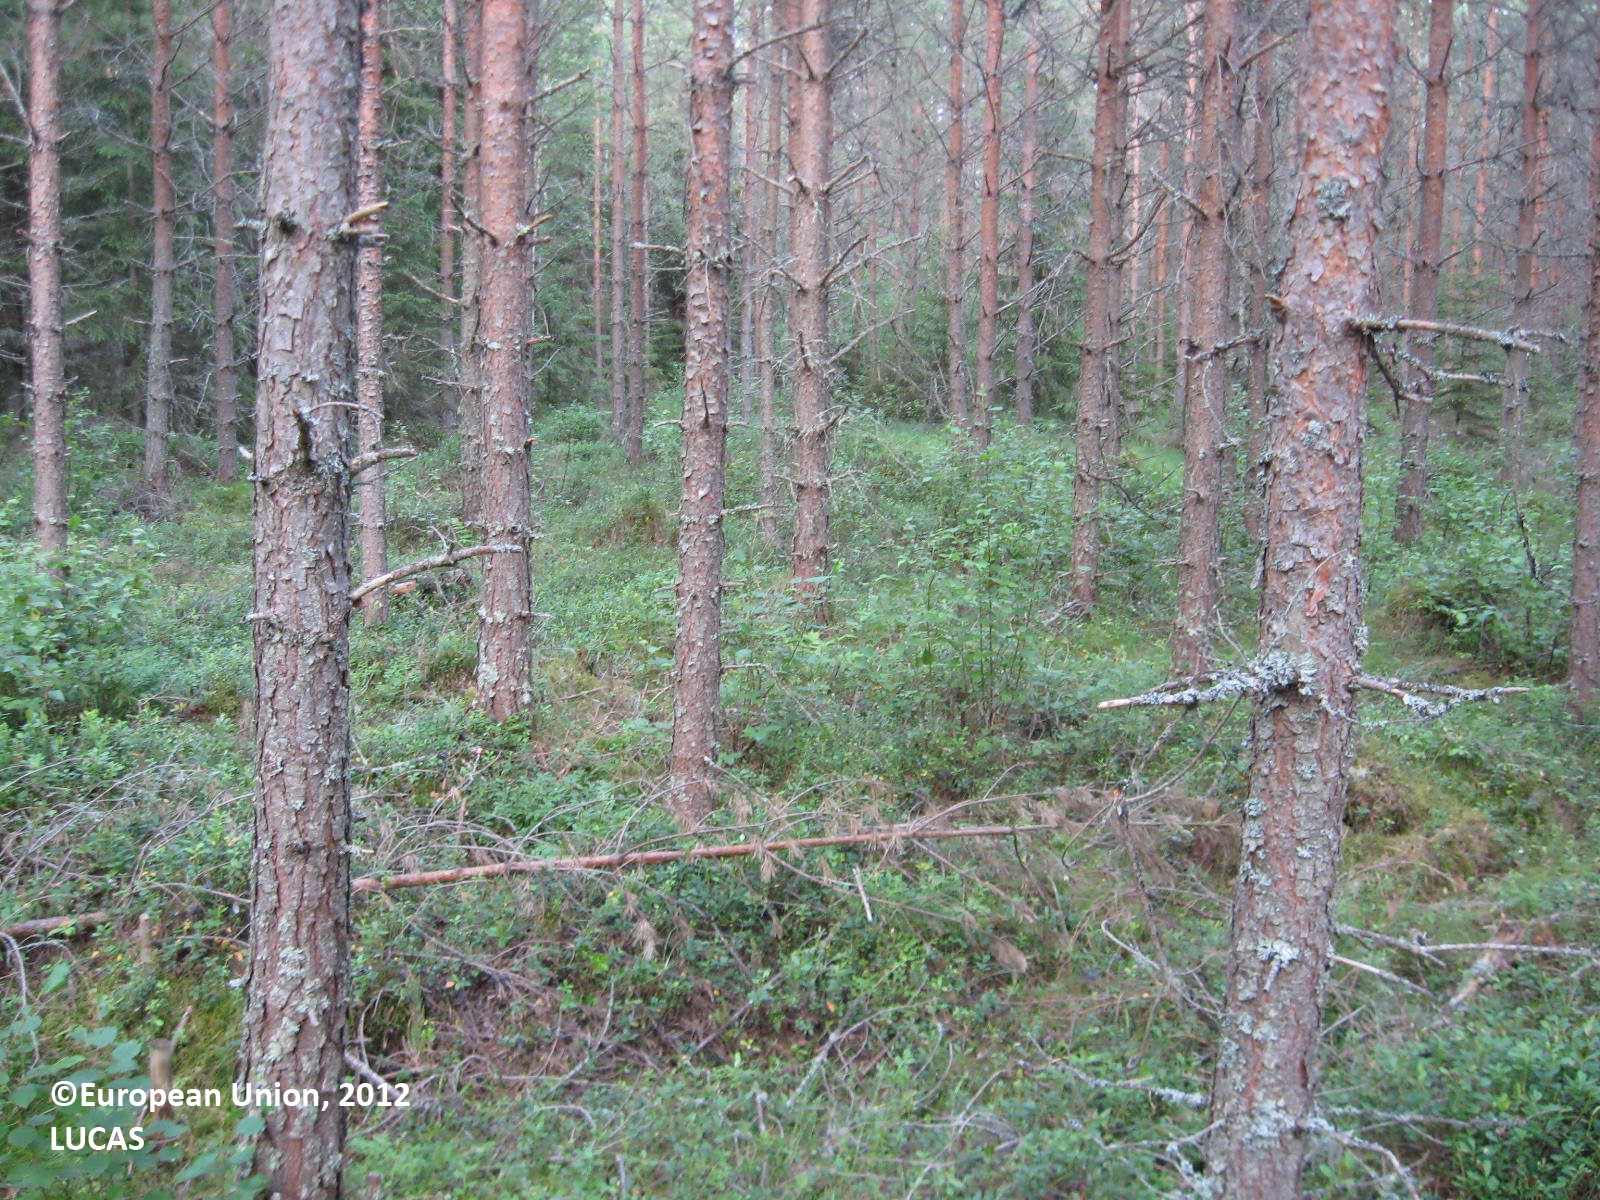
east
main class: Woodland
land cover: Pine dominated coniferous woodland
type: boreal forest
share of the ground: > 75 %
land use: Forestry
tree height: > 5 m
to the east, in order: Pine dominated coniferous woodland; Other coniferous woodland; Ditches and canals; Shruby margins; Paved roads, cycling and walking lanes; Shruby margins; Ditches and canals; Other coniferous woodland
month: July
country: FI
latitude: 62.5893
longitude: 21.5111
